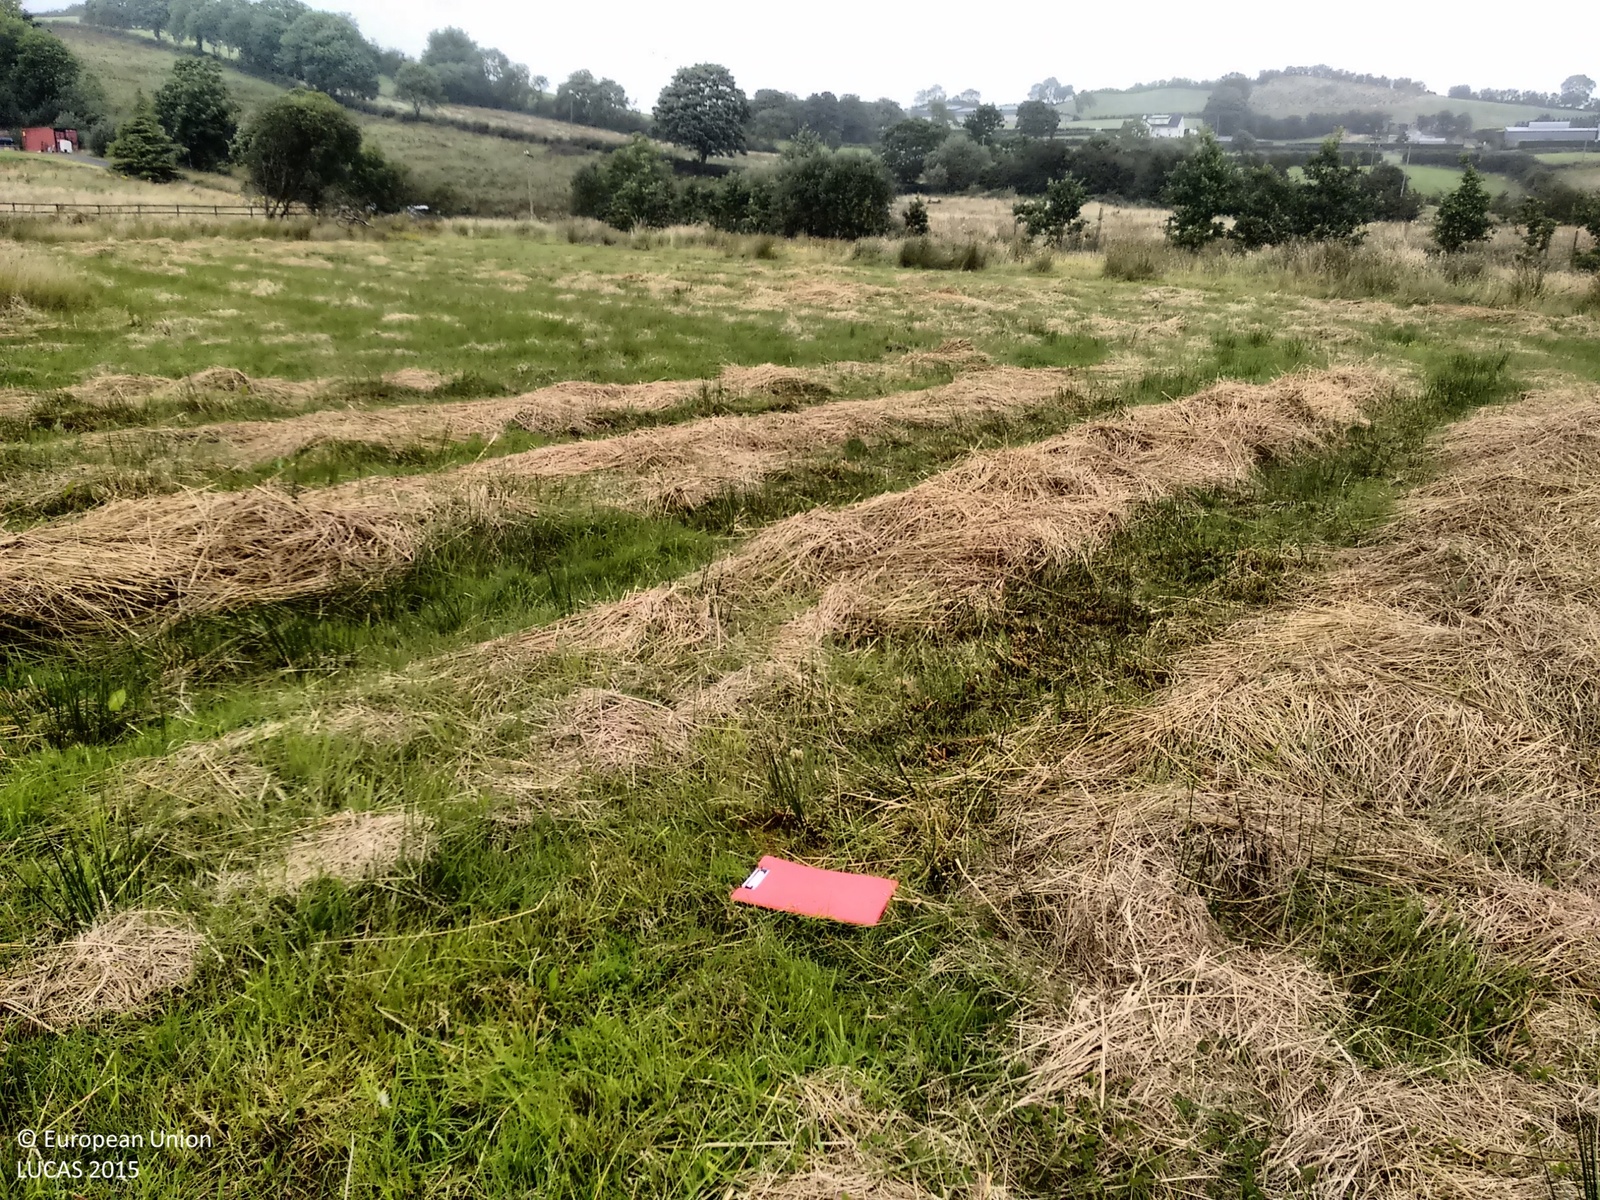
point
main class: Grassland
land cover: Grassland without tree/shrub cover
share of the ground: > 75 %
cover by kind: herbaceous plants 100 %
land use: Agriculture (excluding fallow land and kitchen gardens)
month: August
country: IE
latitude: 54.0553
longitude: -6.8005
